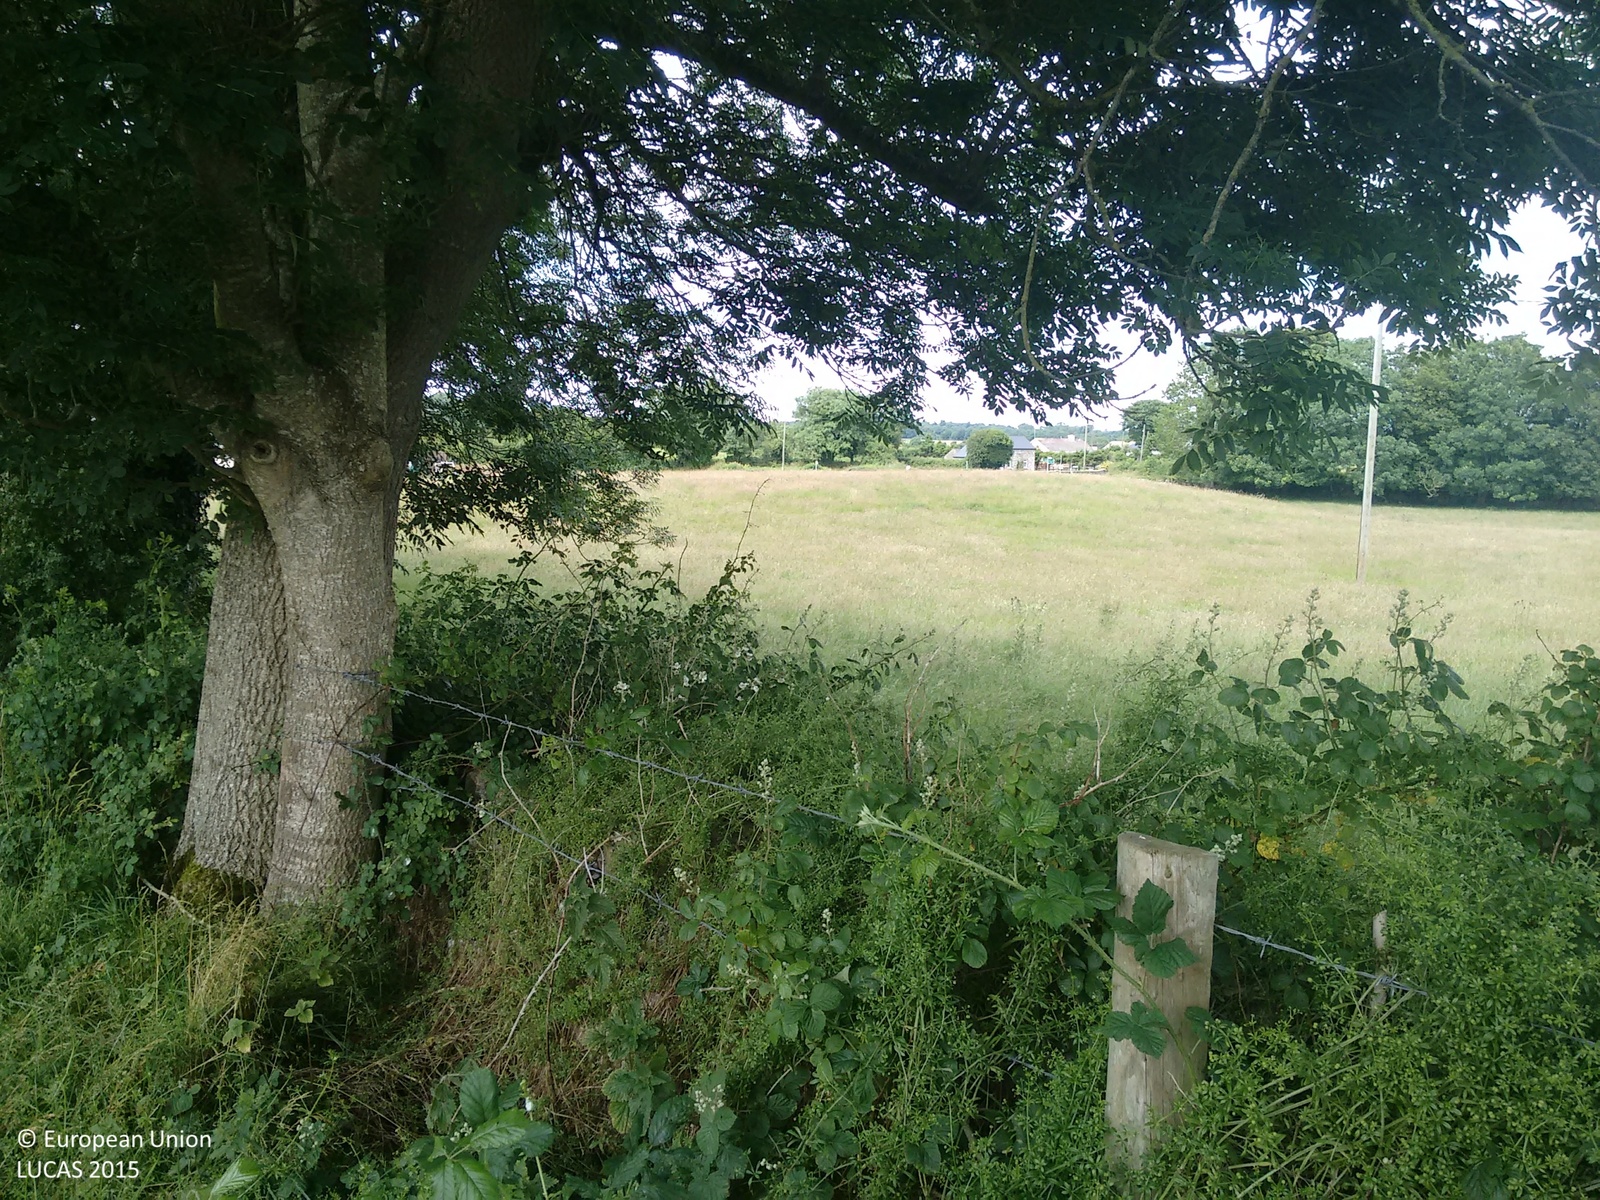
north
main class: Grassland
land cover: Grassland without tree/shrub cover
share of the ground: > 75 %
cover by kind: herbaceous plants 100 %
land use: Agriculture (excluding fallow land and kitchen gardens)
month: July
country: IE
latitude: 53.5458
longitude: -7.7794
